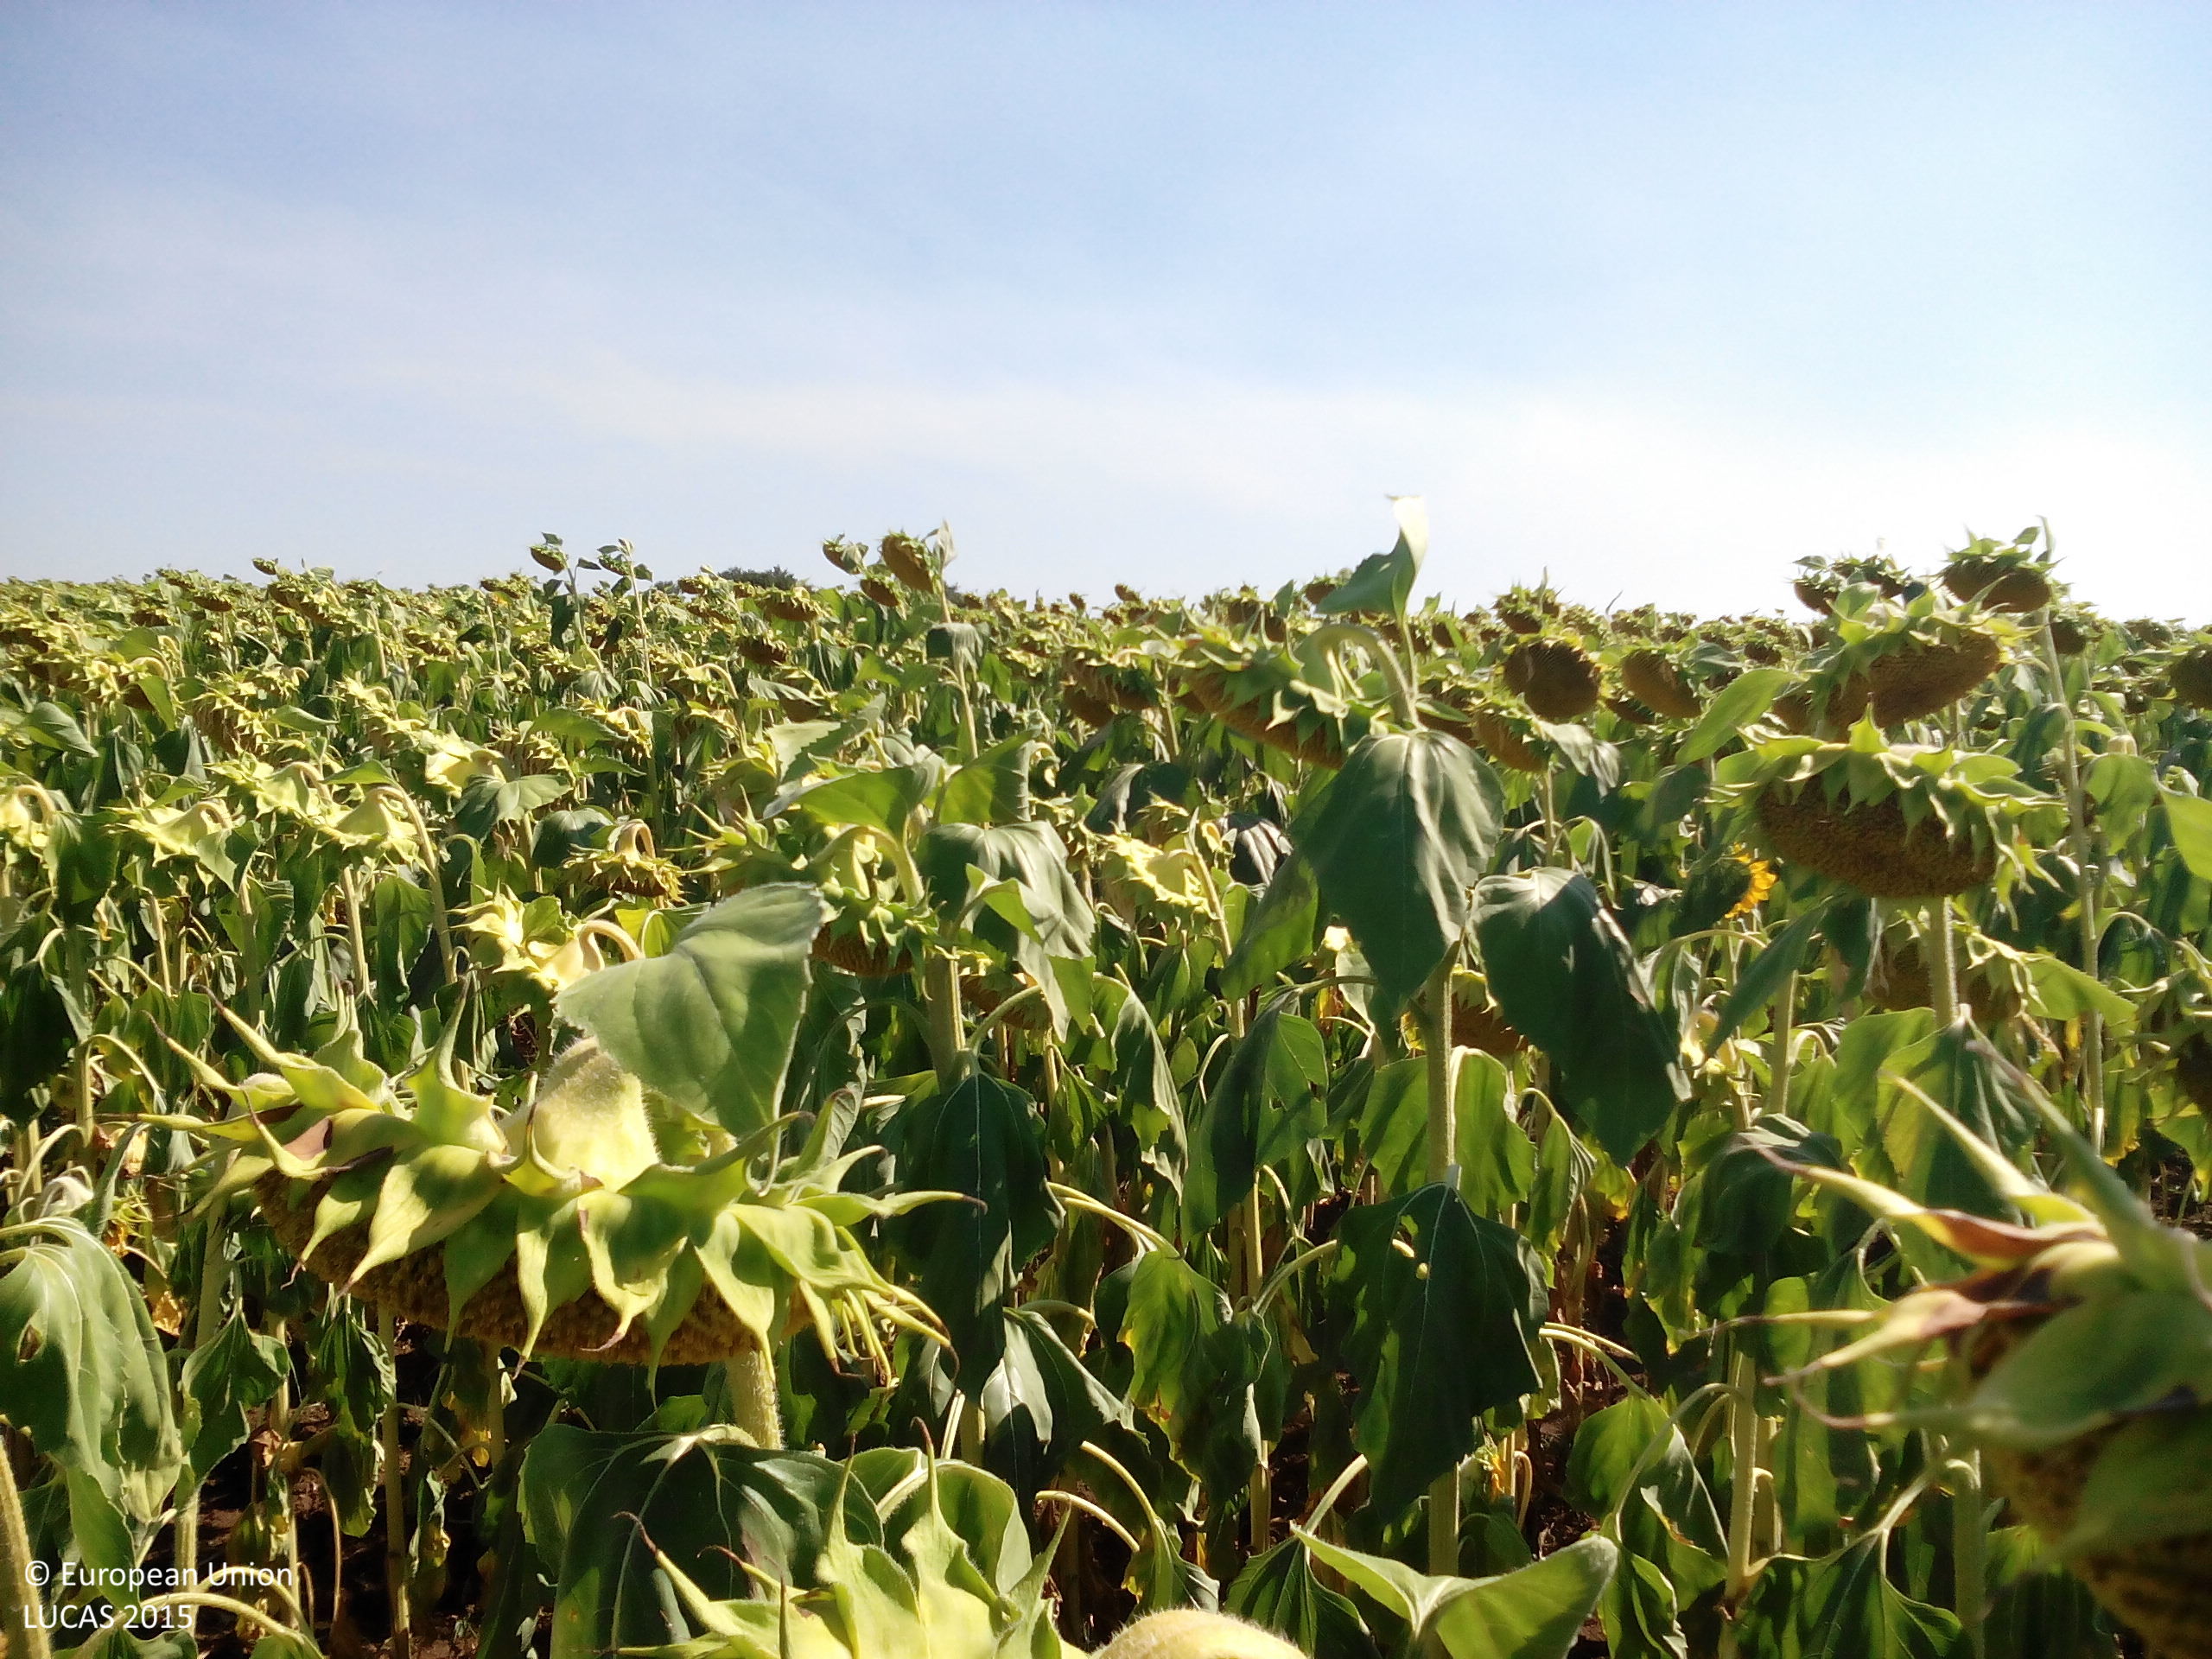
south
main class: Cropland
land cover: Sunflower
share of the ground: > 75 %
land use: Agriculture (excluding fallow land and kitchen gardens)
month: July
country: BG
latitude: 43.2899
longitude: 24.3662
